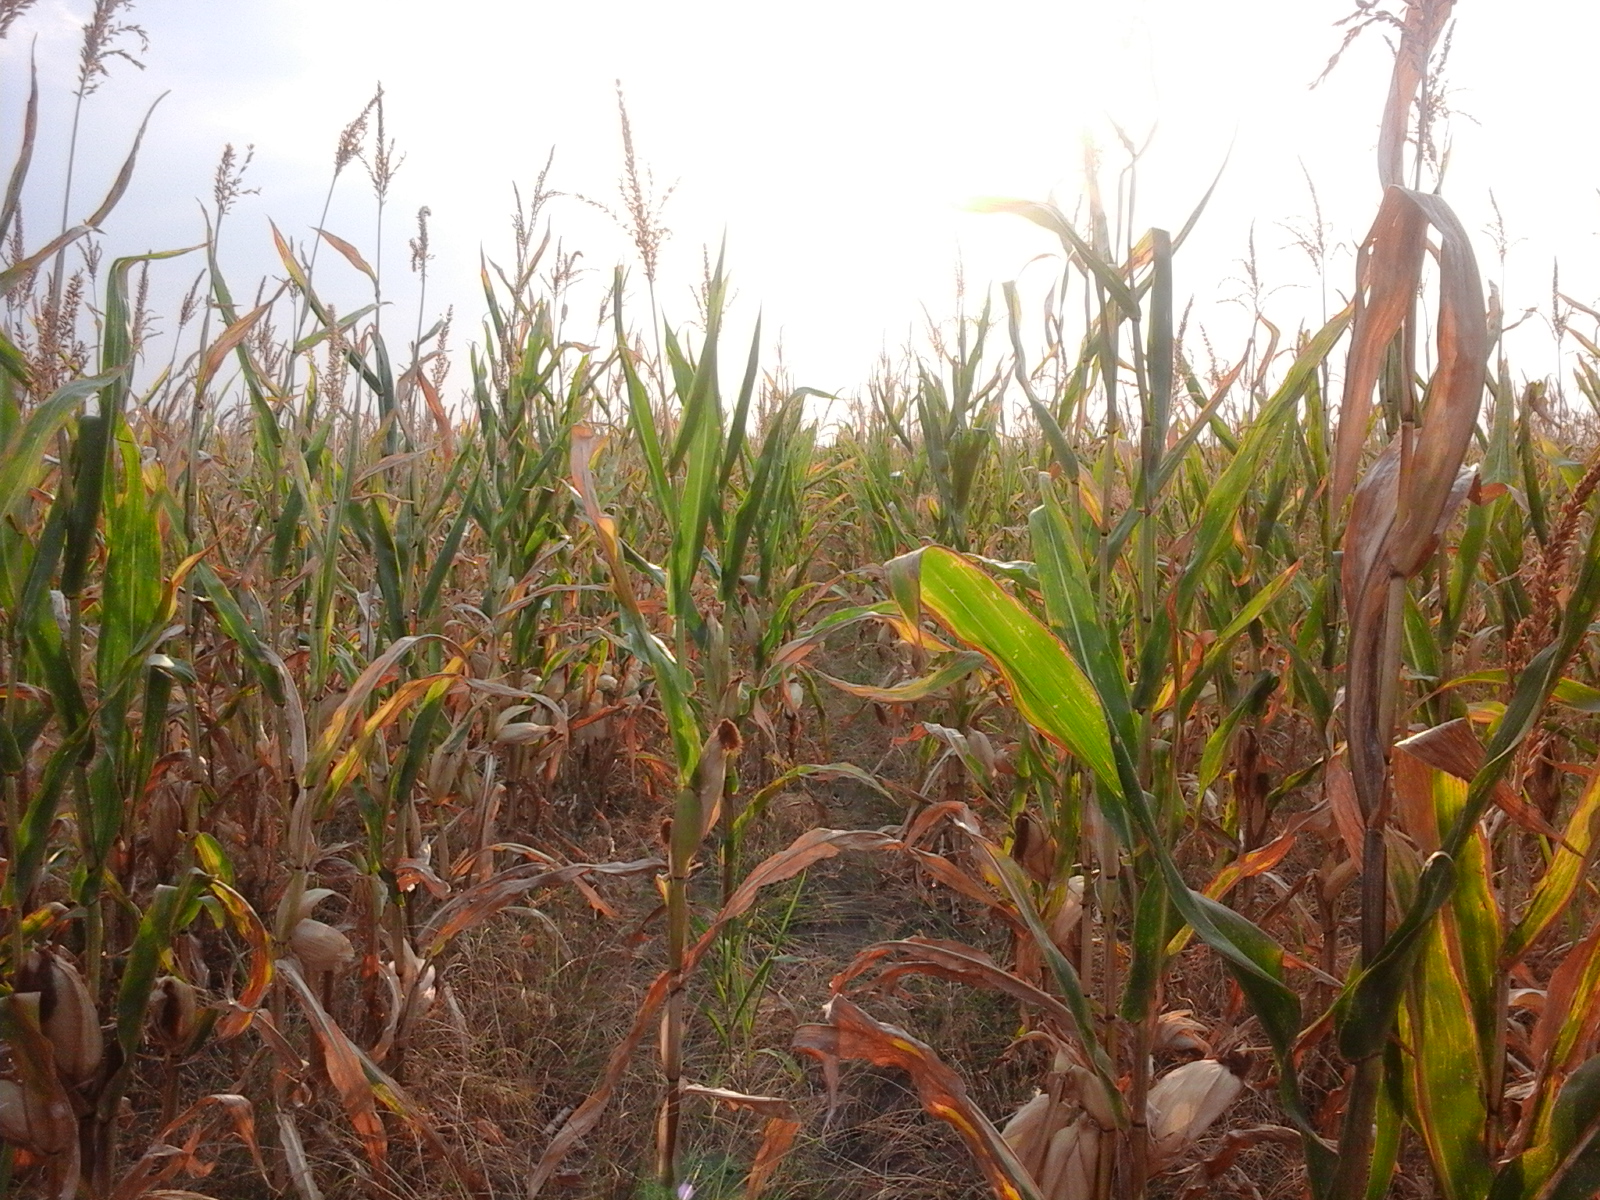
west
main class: Cropland
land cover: Maize
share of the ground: > 75 %
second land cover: Spontaneously vegetated surfaces
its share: > 75 %
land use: Agriculture (excluding fallow land and kitchen gardens)
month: August
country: RO
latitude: 44.0574
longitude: 23.2907
